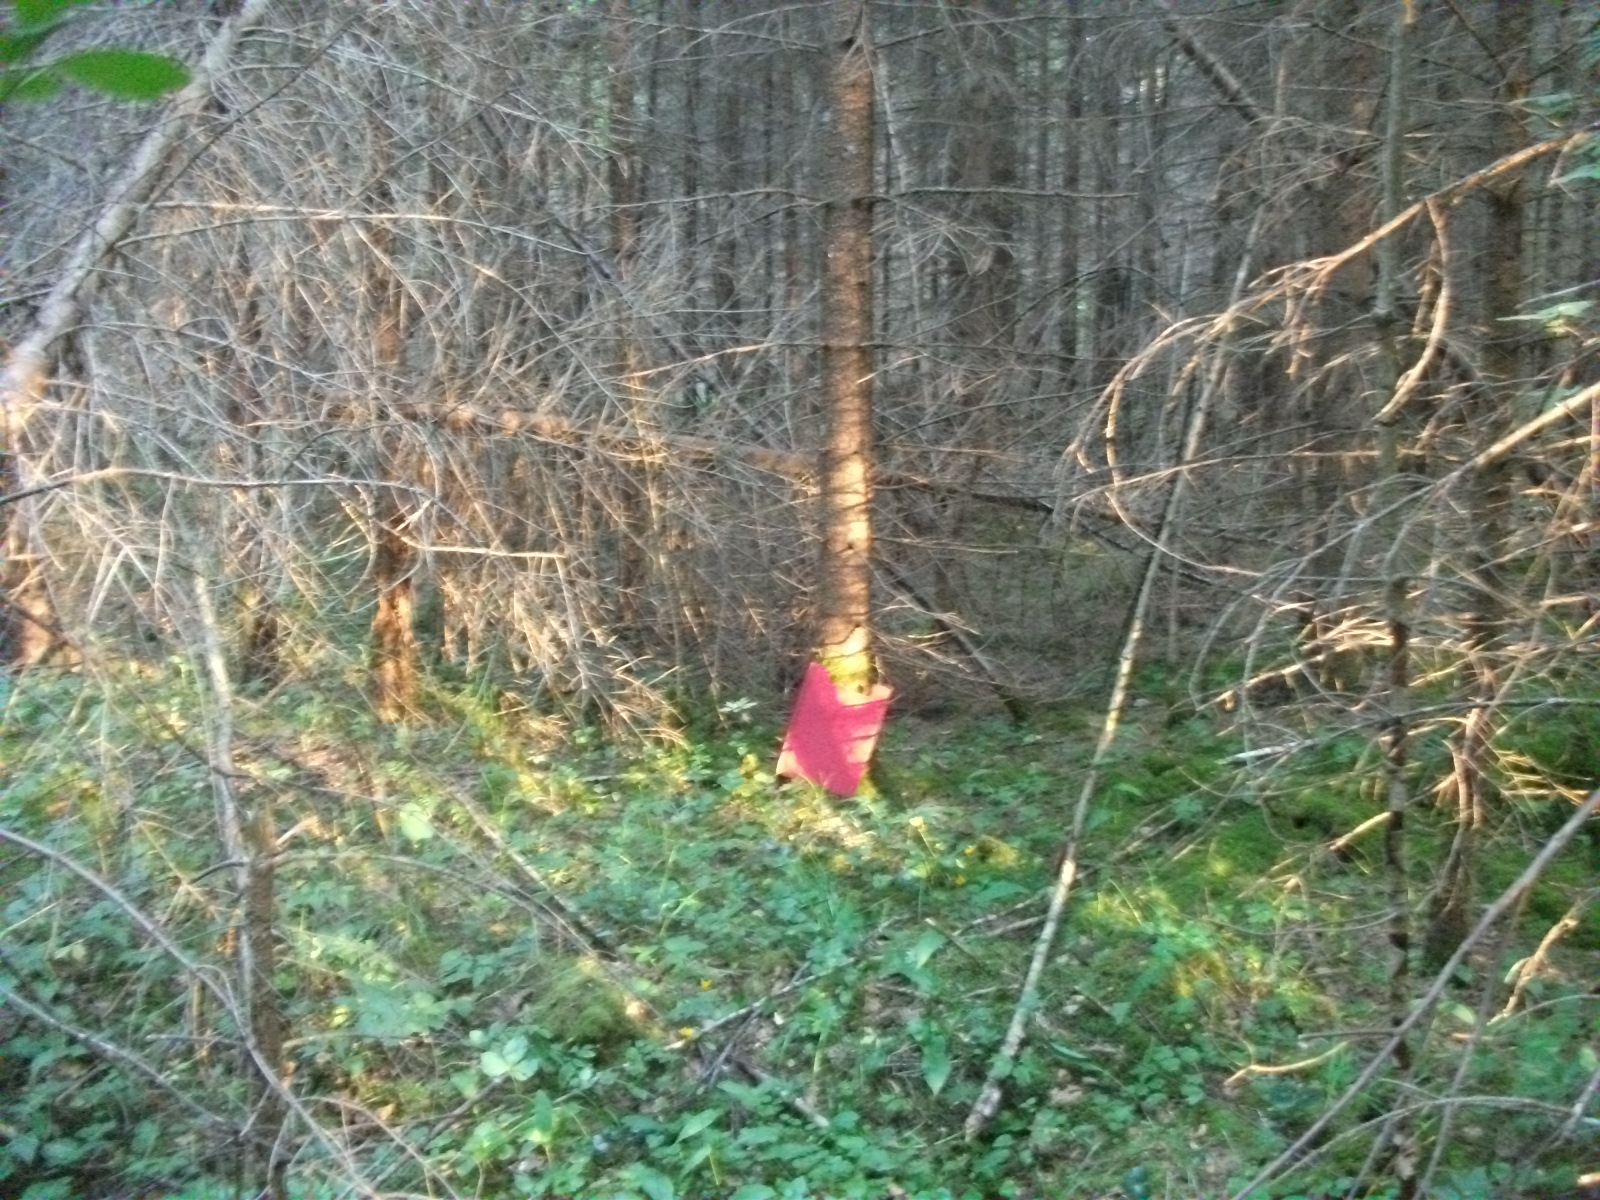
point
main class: Woodland
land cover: Spruce dominated coniferous woodland
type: hemiboreal forest and nemoral coniferous forest and mixed broadleaved-coniferous forest
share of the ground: > 75 %
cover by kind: coniferous forest trees 80 %, herbaceous plants 10 %, lichens and mosses 10 %
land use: Forestry
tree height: > 5 m
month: July
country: LV
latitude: 56.7877
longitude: 26.4659
